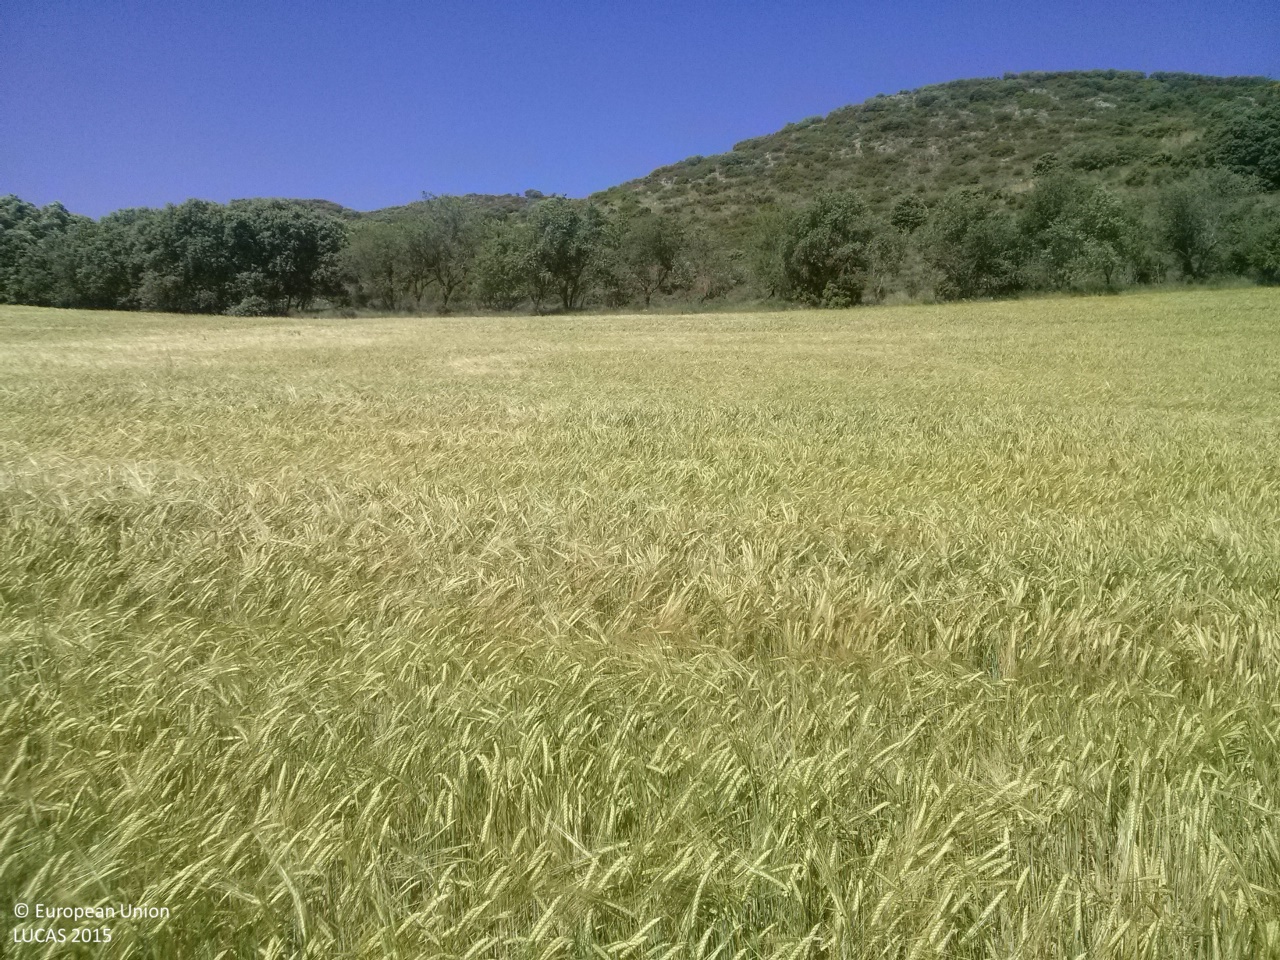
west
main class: Cropland
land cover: Barley
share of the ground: > 75 %
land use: Agriculture (excluding fallow land and kitchen gardens)
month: May
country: ES
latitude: 40.1736
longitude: -2.8119
